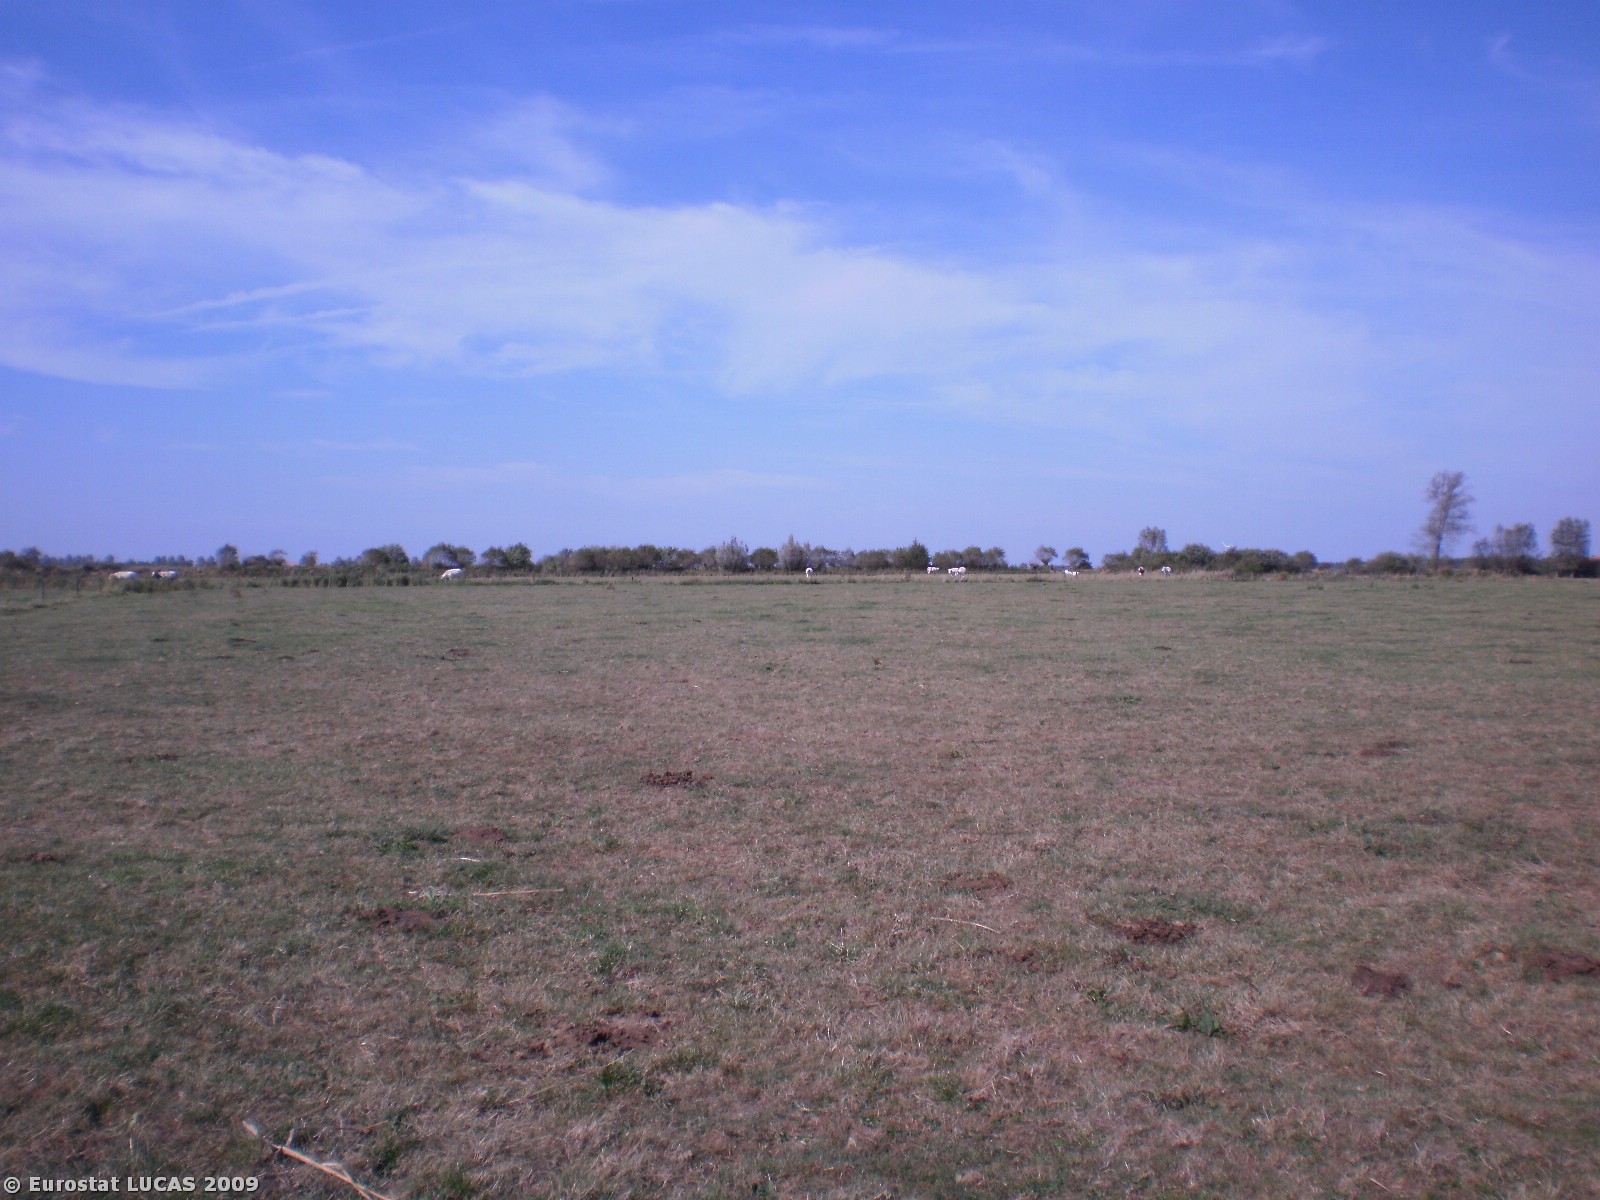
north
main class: Grassland
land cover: Grassland without tree/shrub cover
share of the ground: > 75 %
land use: Agriculture (excluding fallow land and kitchen gardens)
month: September
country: BE
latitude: 50.9494
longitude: 2.8006
